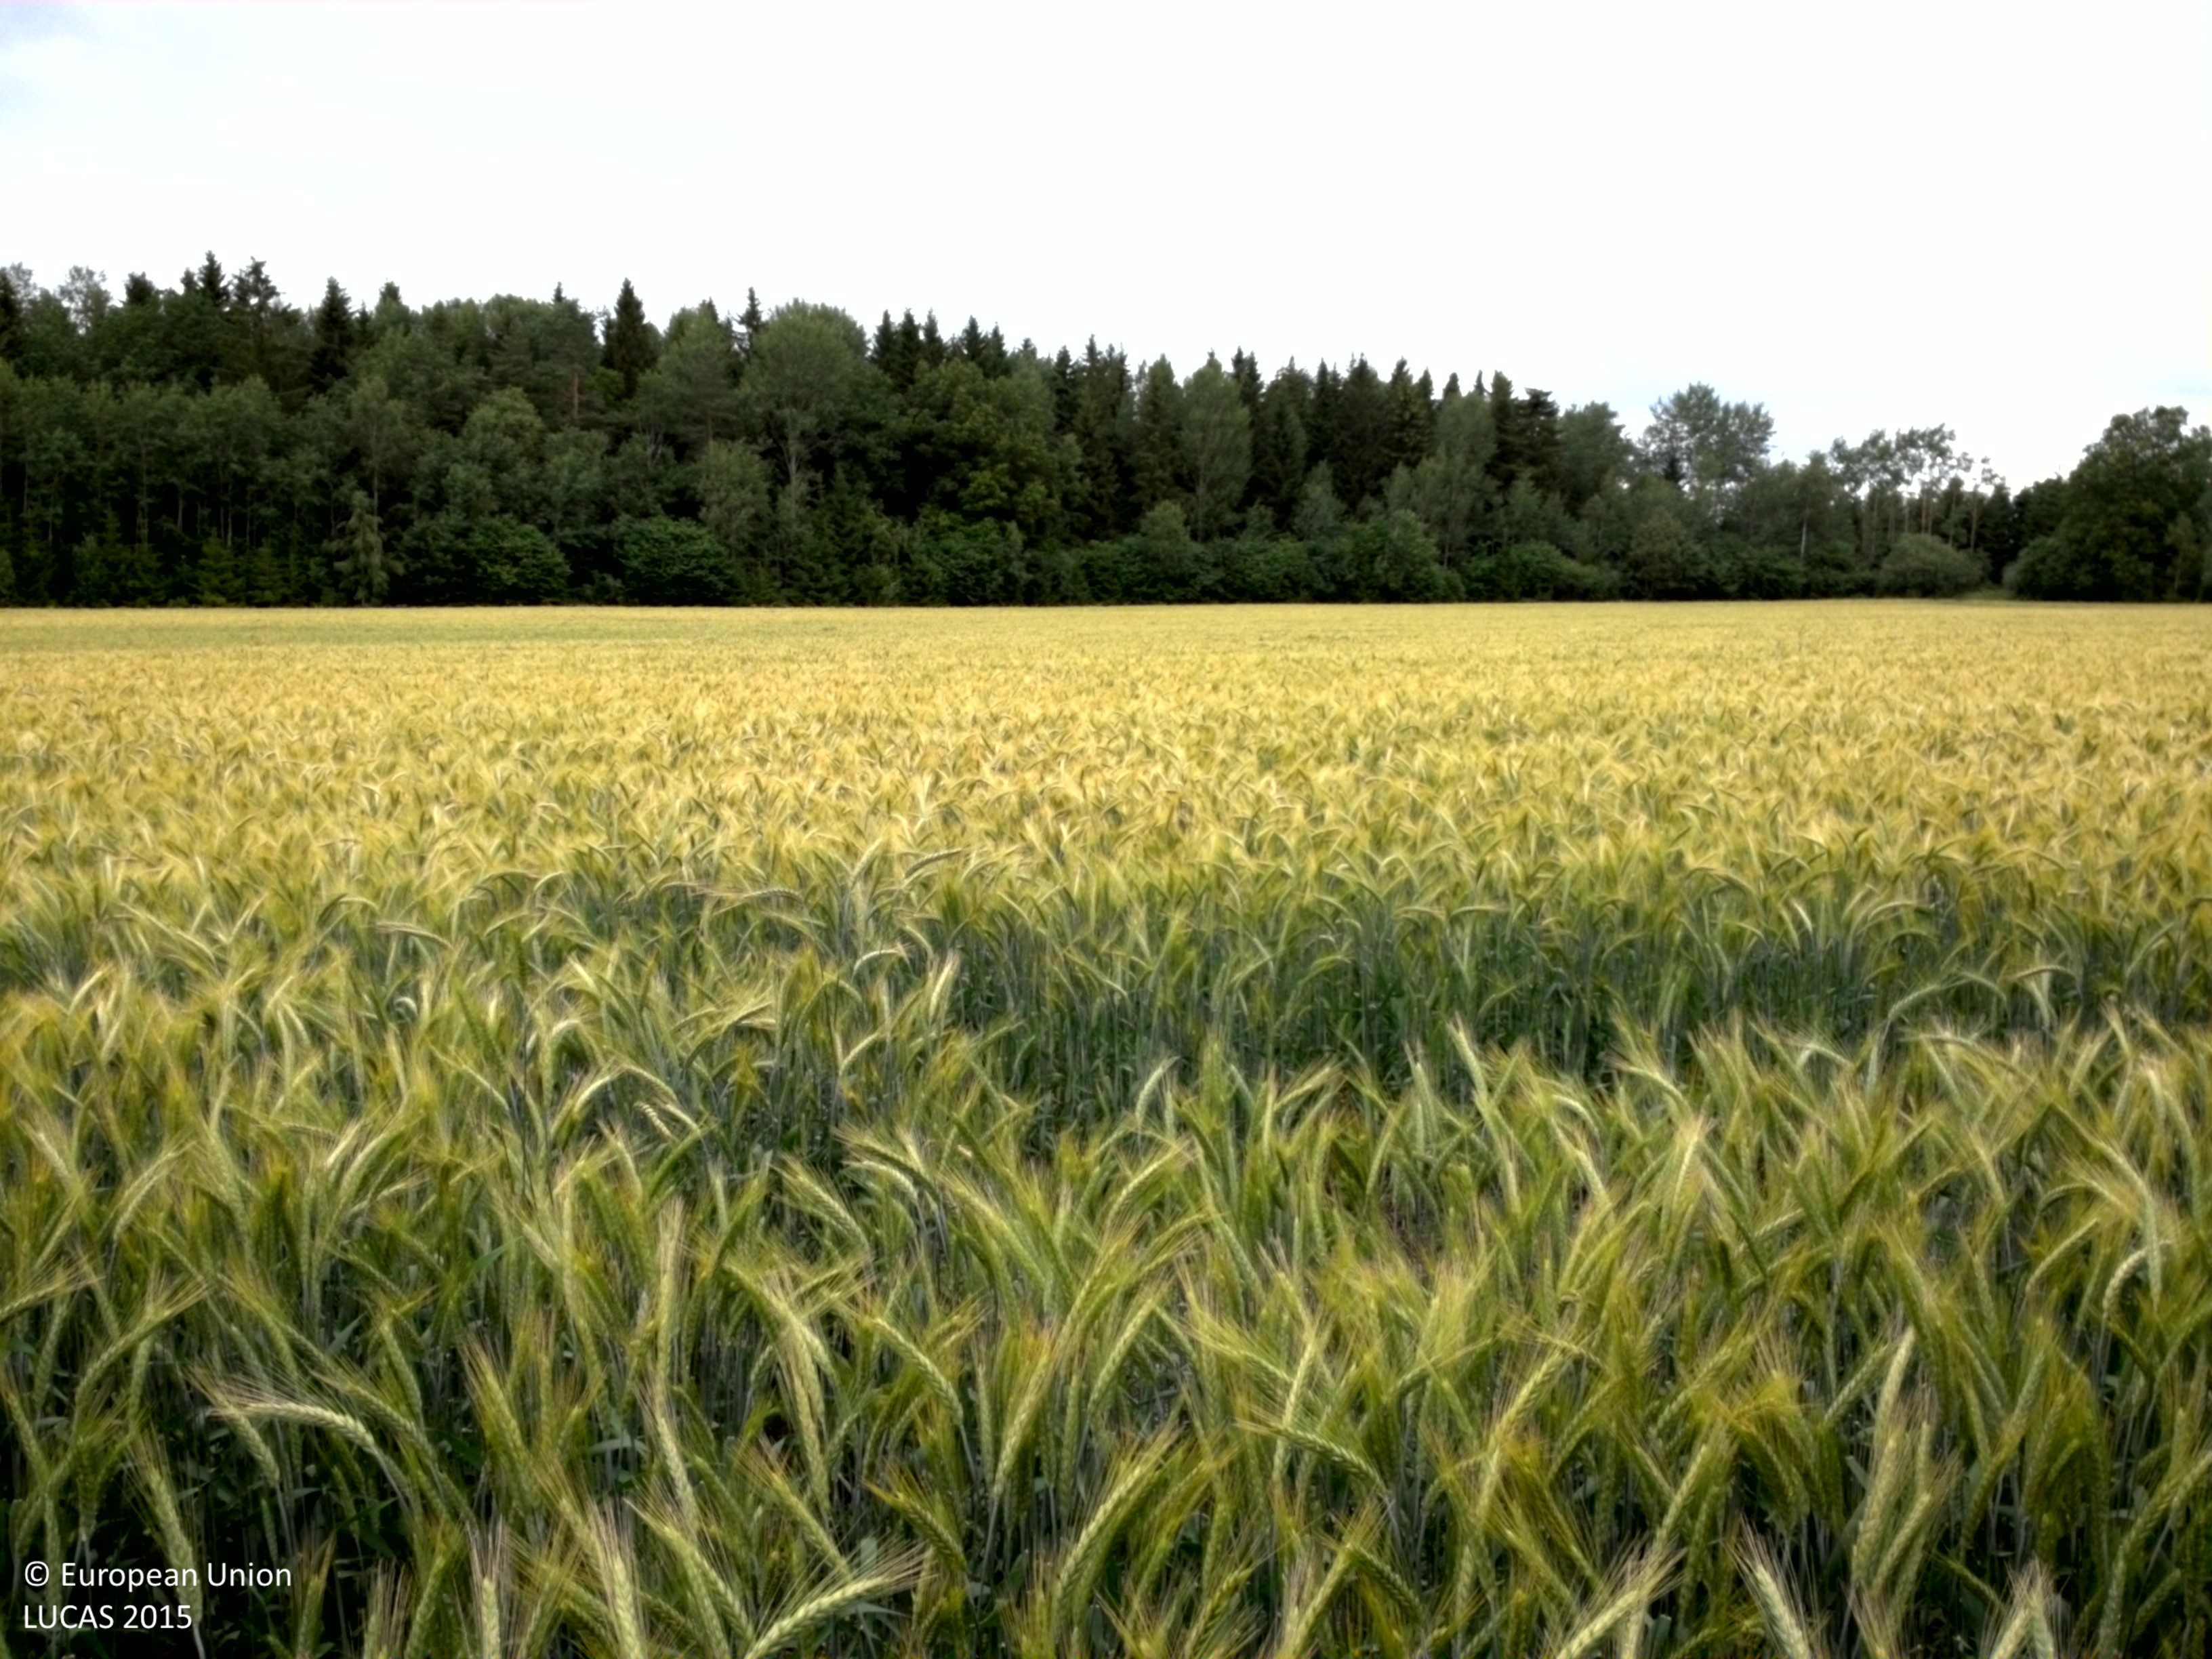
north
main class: Cropland
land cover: Rye
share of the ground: > 75 %
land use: Agriculture (excluding fallow land and kitchen gardens)
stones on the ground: < 10 %
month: July
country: SE
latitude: 59.7771
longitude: 18.5302
